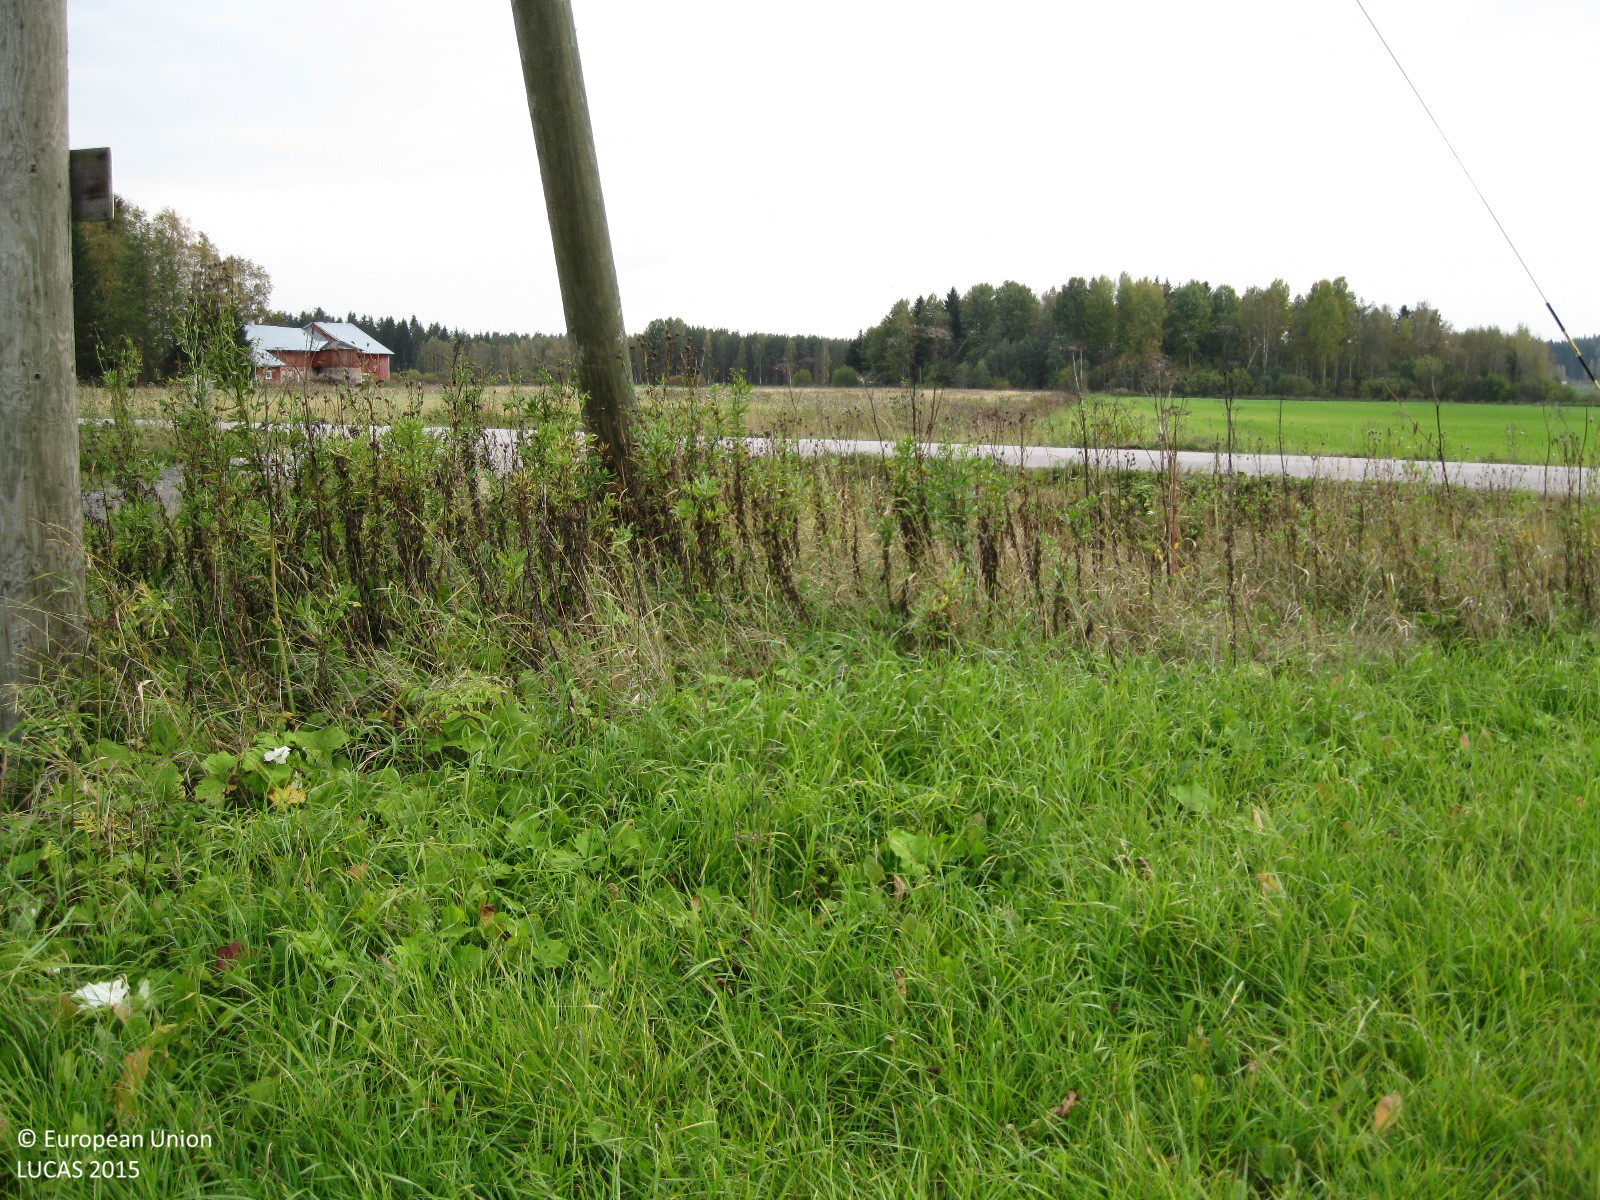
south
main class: Cropland
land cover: Temporary grasslands
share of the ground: > 75 %
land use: Agriculture (excluding fallow land and kitchen gardens)
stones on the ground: < 10 %
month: September
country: FI
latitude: 60.5842
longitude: 24.6566
